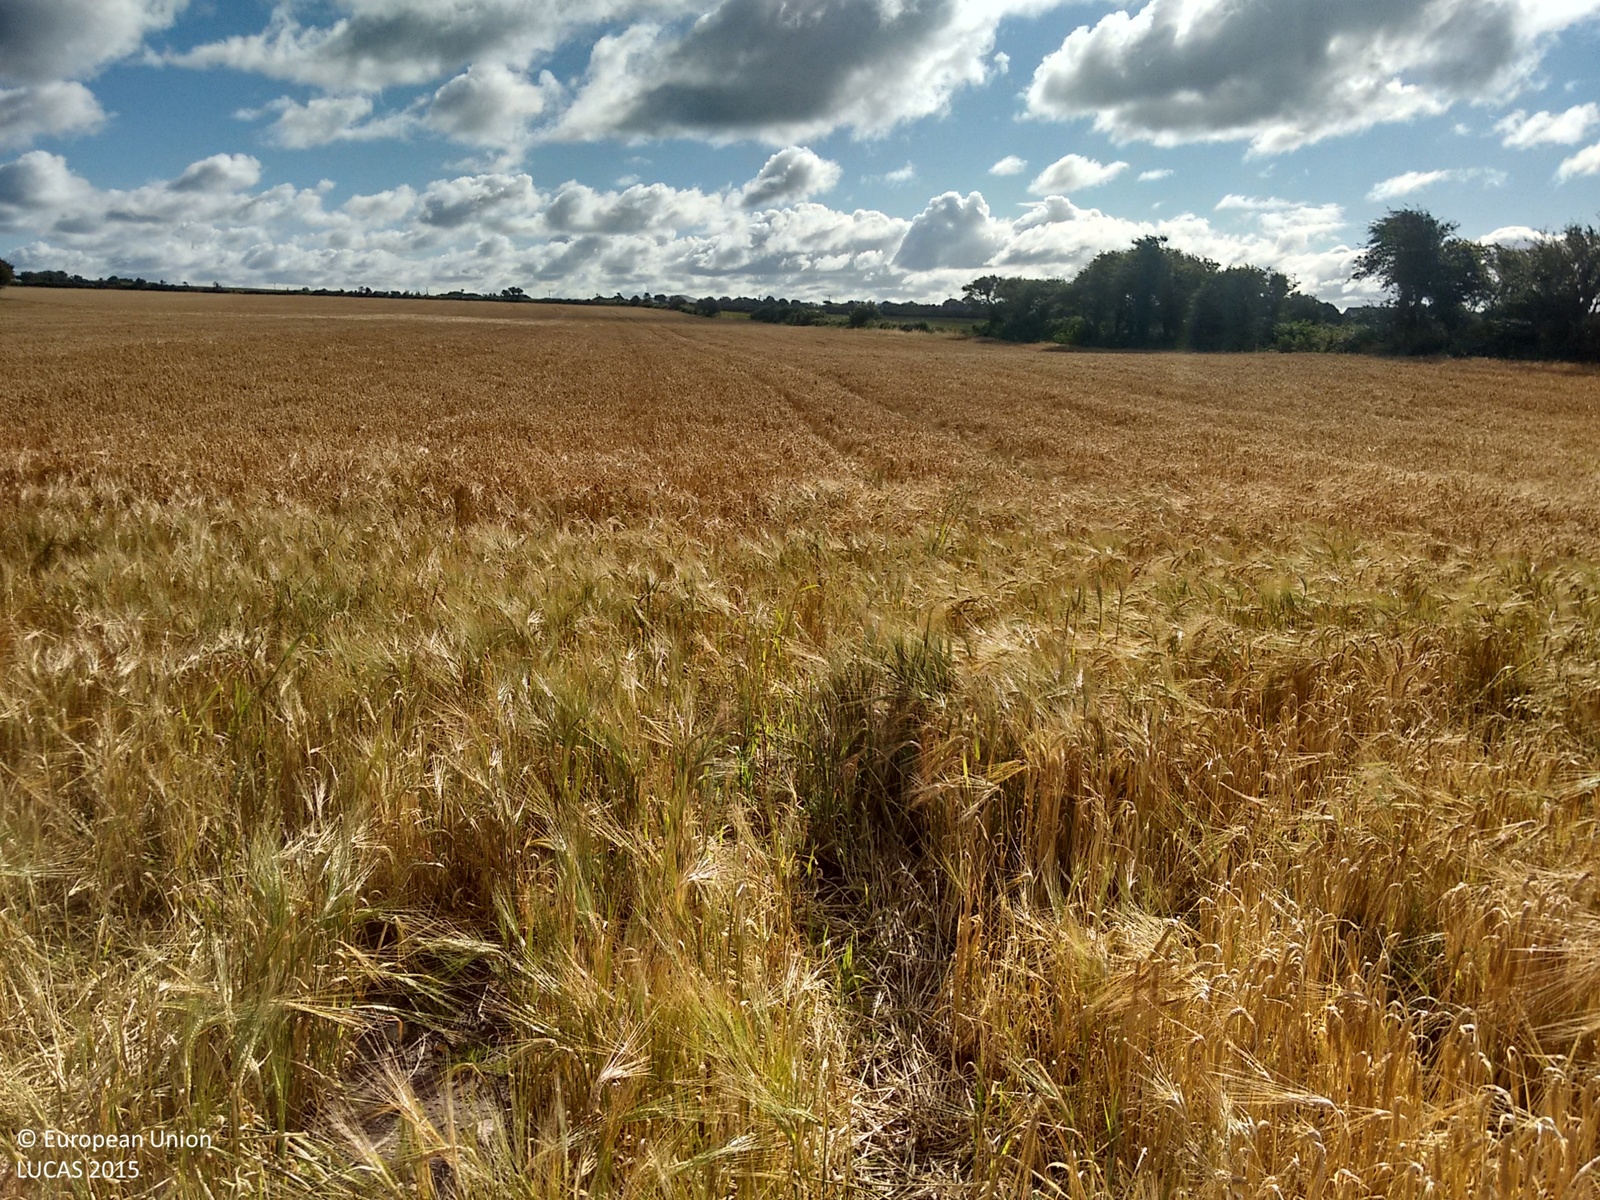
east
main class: Cropland
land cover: Barley
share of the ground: > 75 %
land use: Agriculture (excluding fallow land and kitchen gardens)
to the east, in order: Barley; Abandoned hedges; Sugar beet
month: September
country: IE
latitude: 52.3165
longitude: -9.8003
